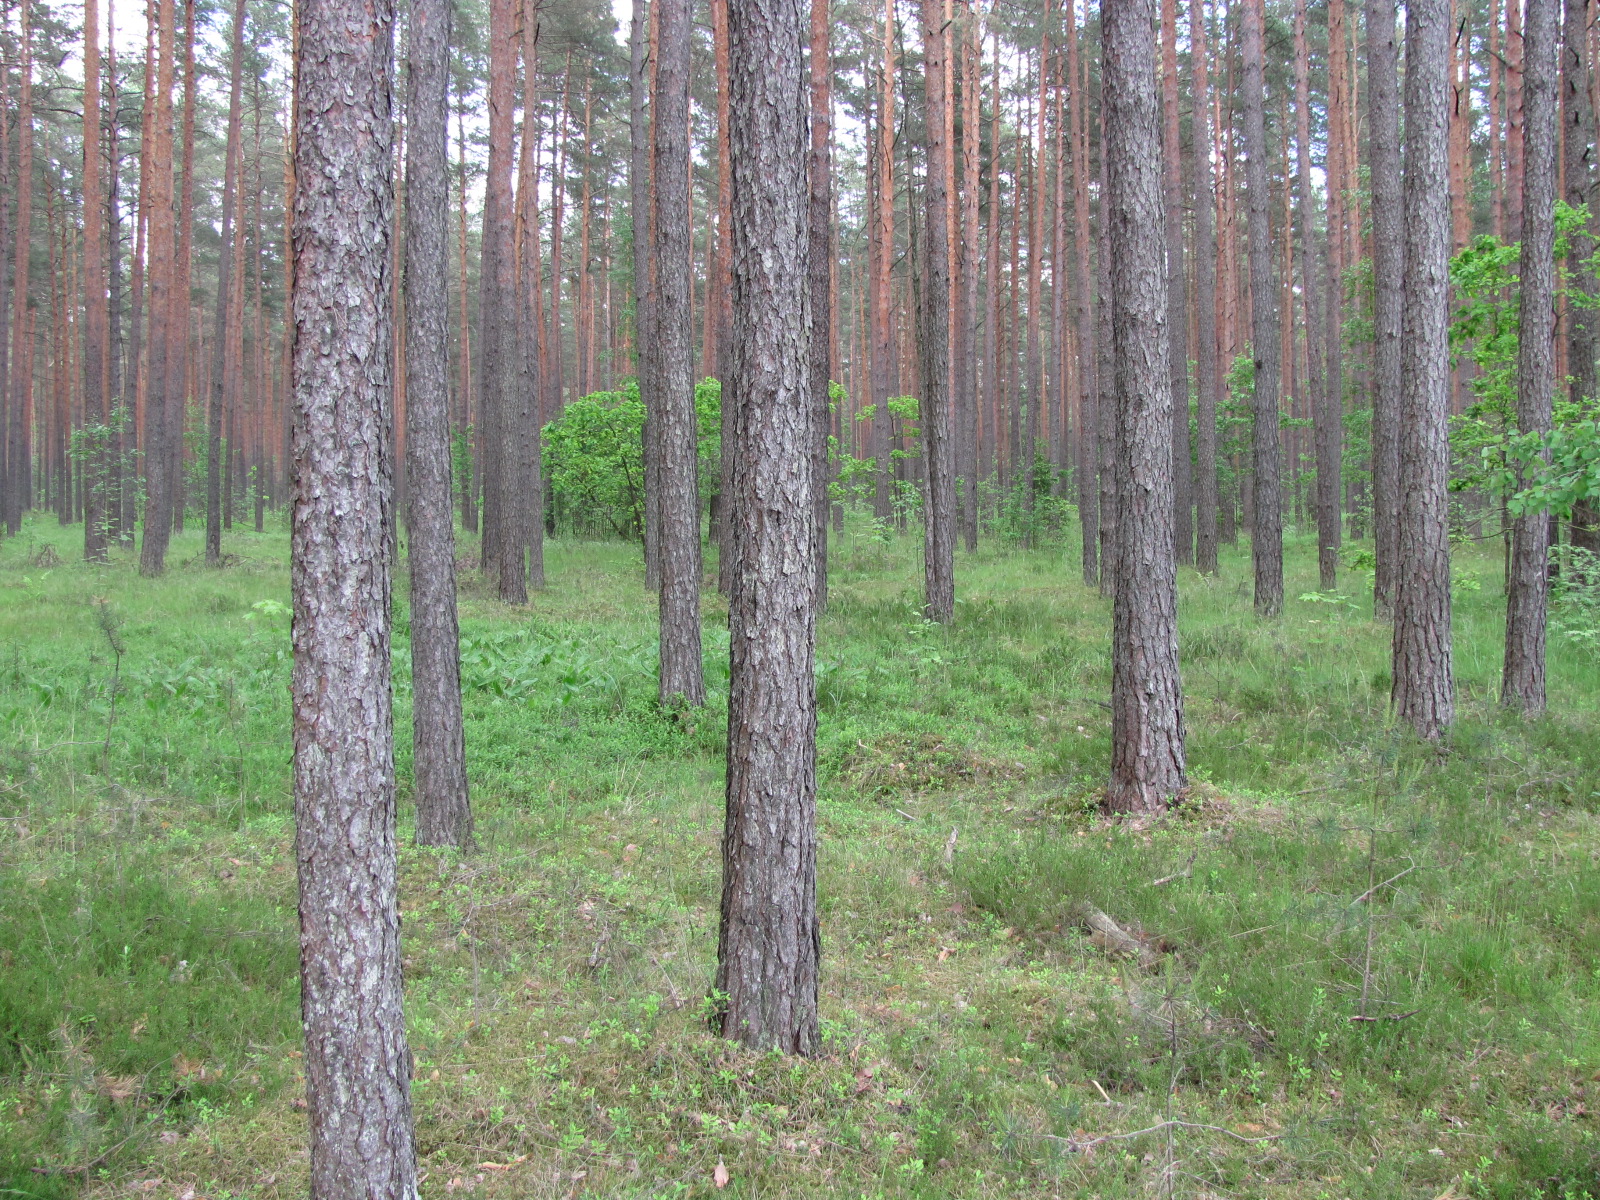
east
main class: Woodland
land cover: Pine dominated coniferous woodland
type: hemiboreal forest and nemoral coniferous forest and mixed broadleaved-coniferous forest
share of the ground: > 75 %
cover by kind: coniferous forest trees 85 %, lichens and mosses 10 %, herbaceous plants 5 %
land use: Forestry
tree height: > 5 m
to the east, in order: Pine dominated coniferous woodland; Tracks; Pine dominated coniferous woodland; Tracks
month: June
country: LV
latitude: 56.9534
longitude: 24.3122
